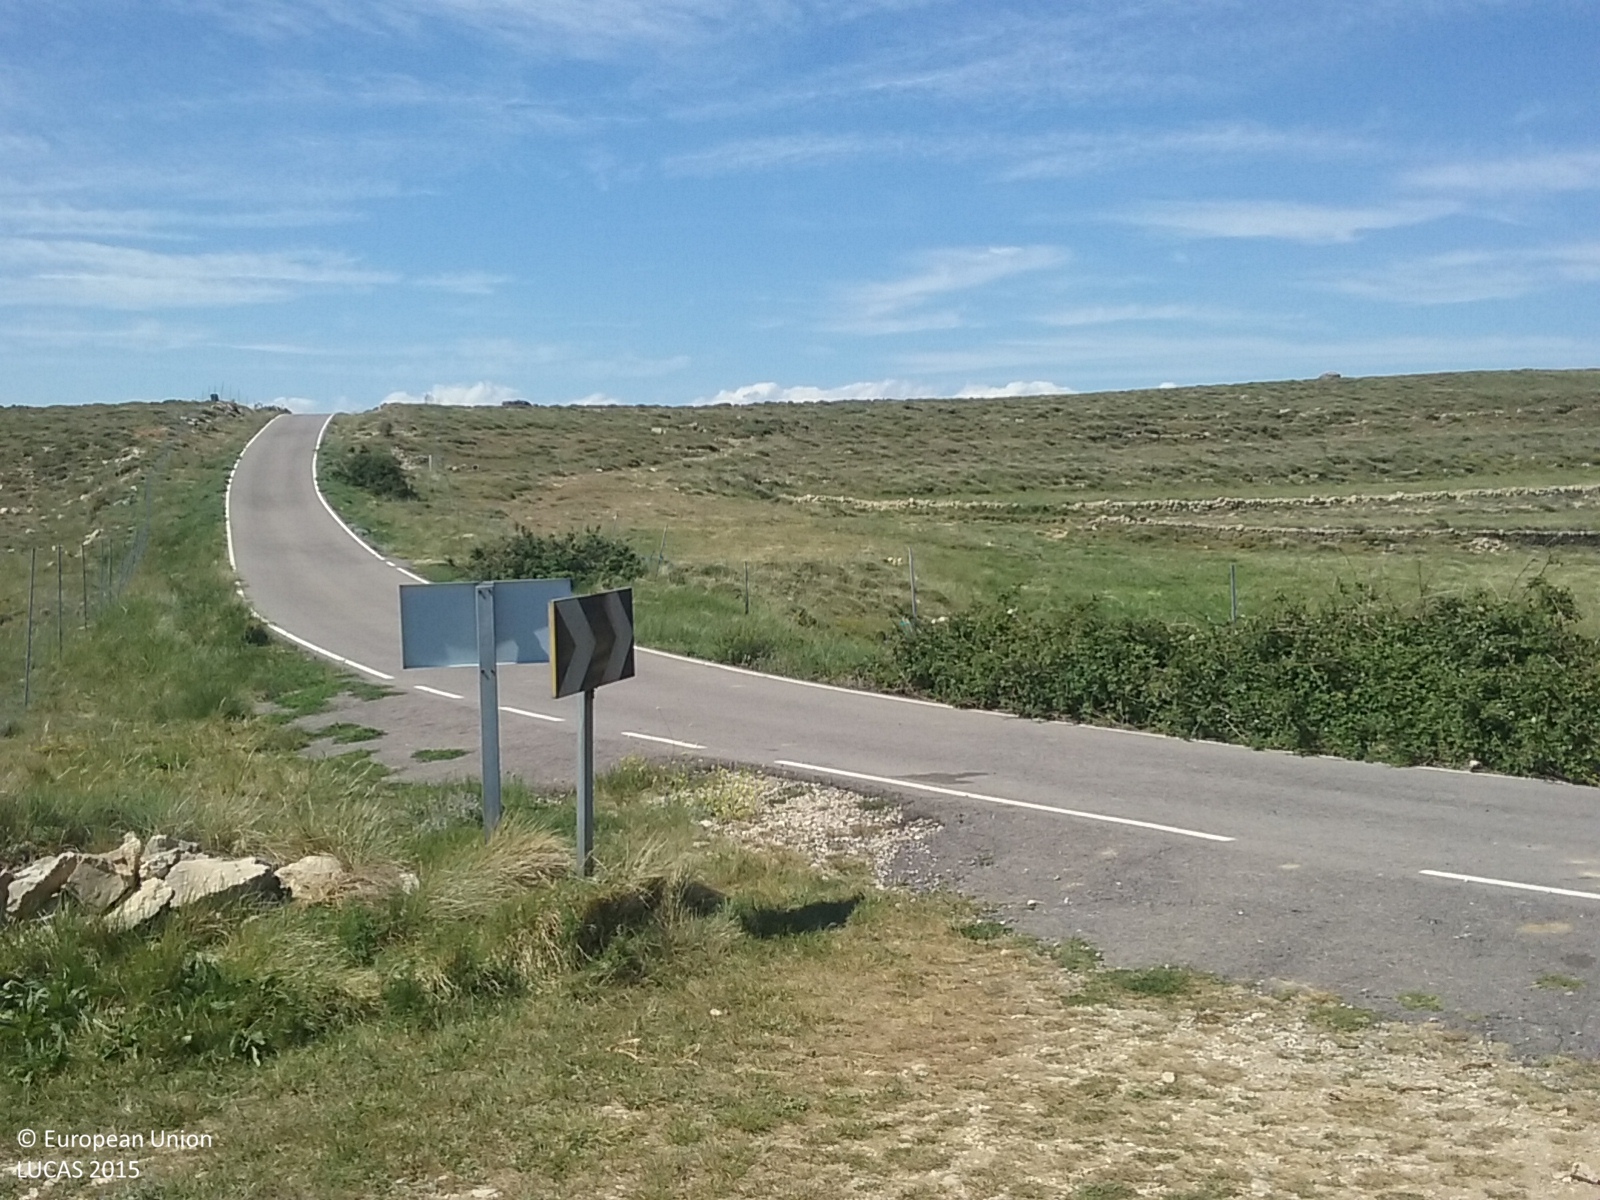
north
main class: Grassland
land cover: Grassland without tree/shrub cover
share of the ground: 25 - 50 %
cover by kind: herbaceous plants 20 %
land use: Abandoned areas
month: May
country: ES
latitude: 40.4589
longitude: -0.0647
